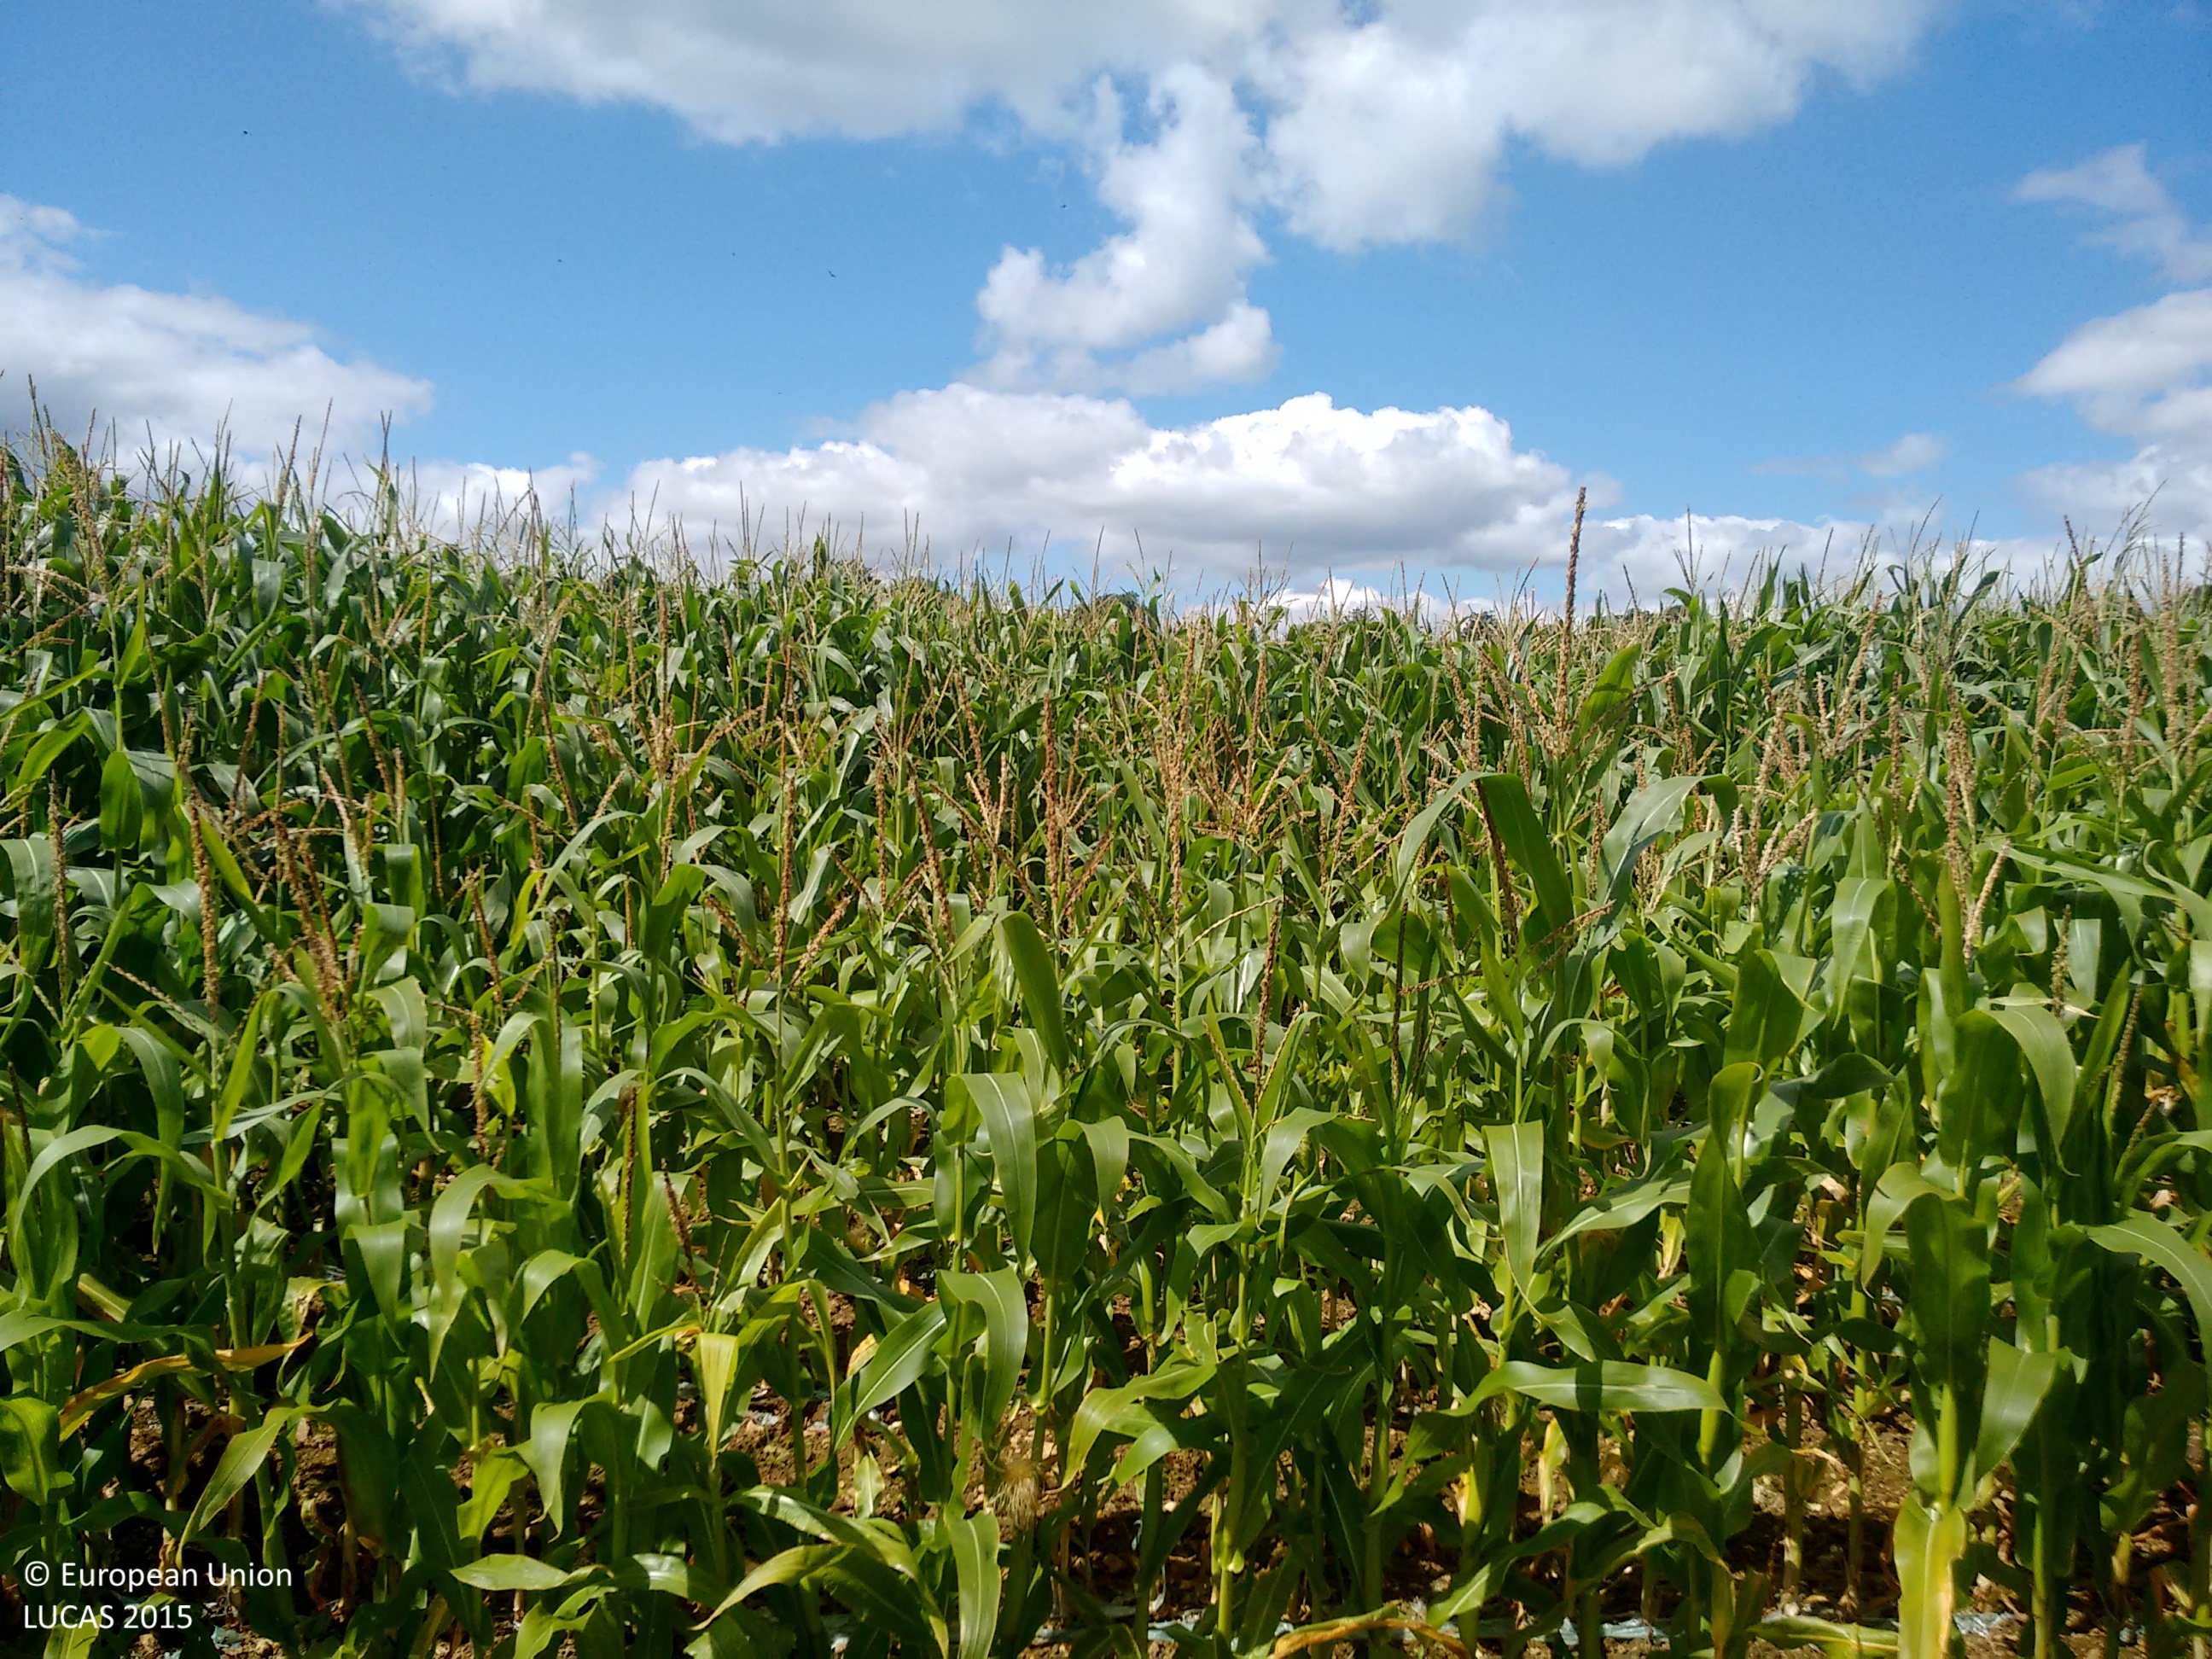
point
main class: Cropland
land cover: Maize
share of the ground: > 75 %
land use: Agriculture (excluding fallow land and kitchen gardens)
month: July
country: GB
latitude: 50.7863
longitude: -3.1412
